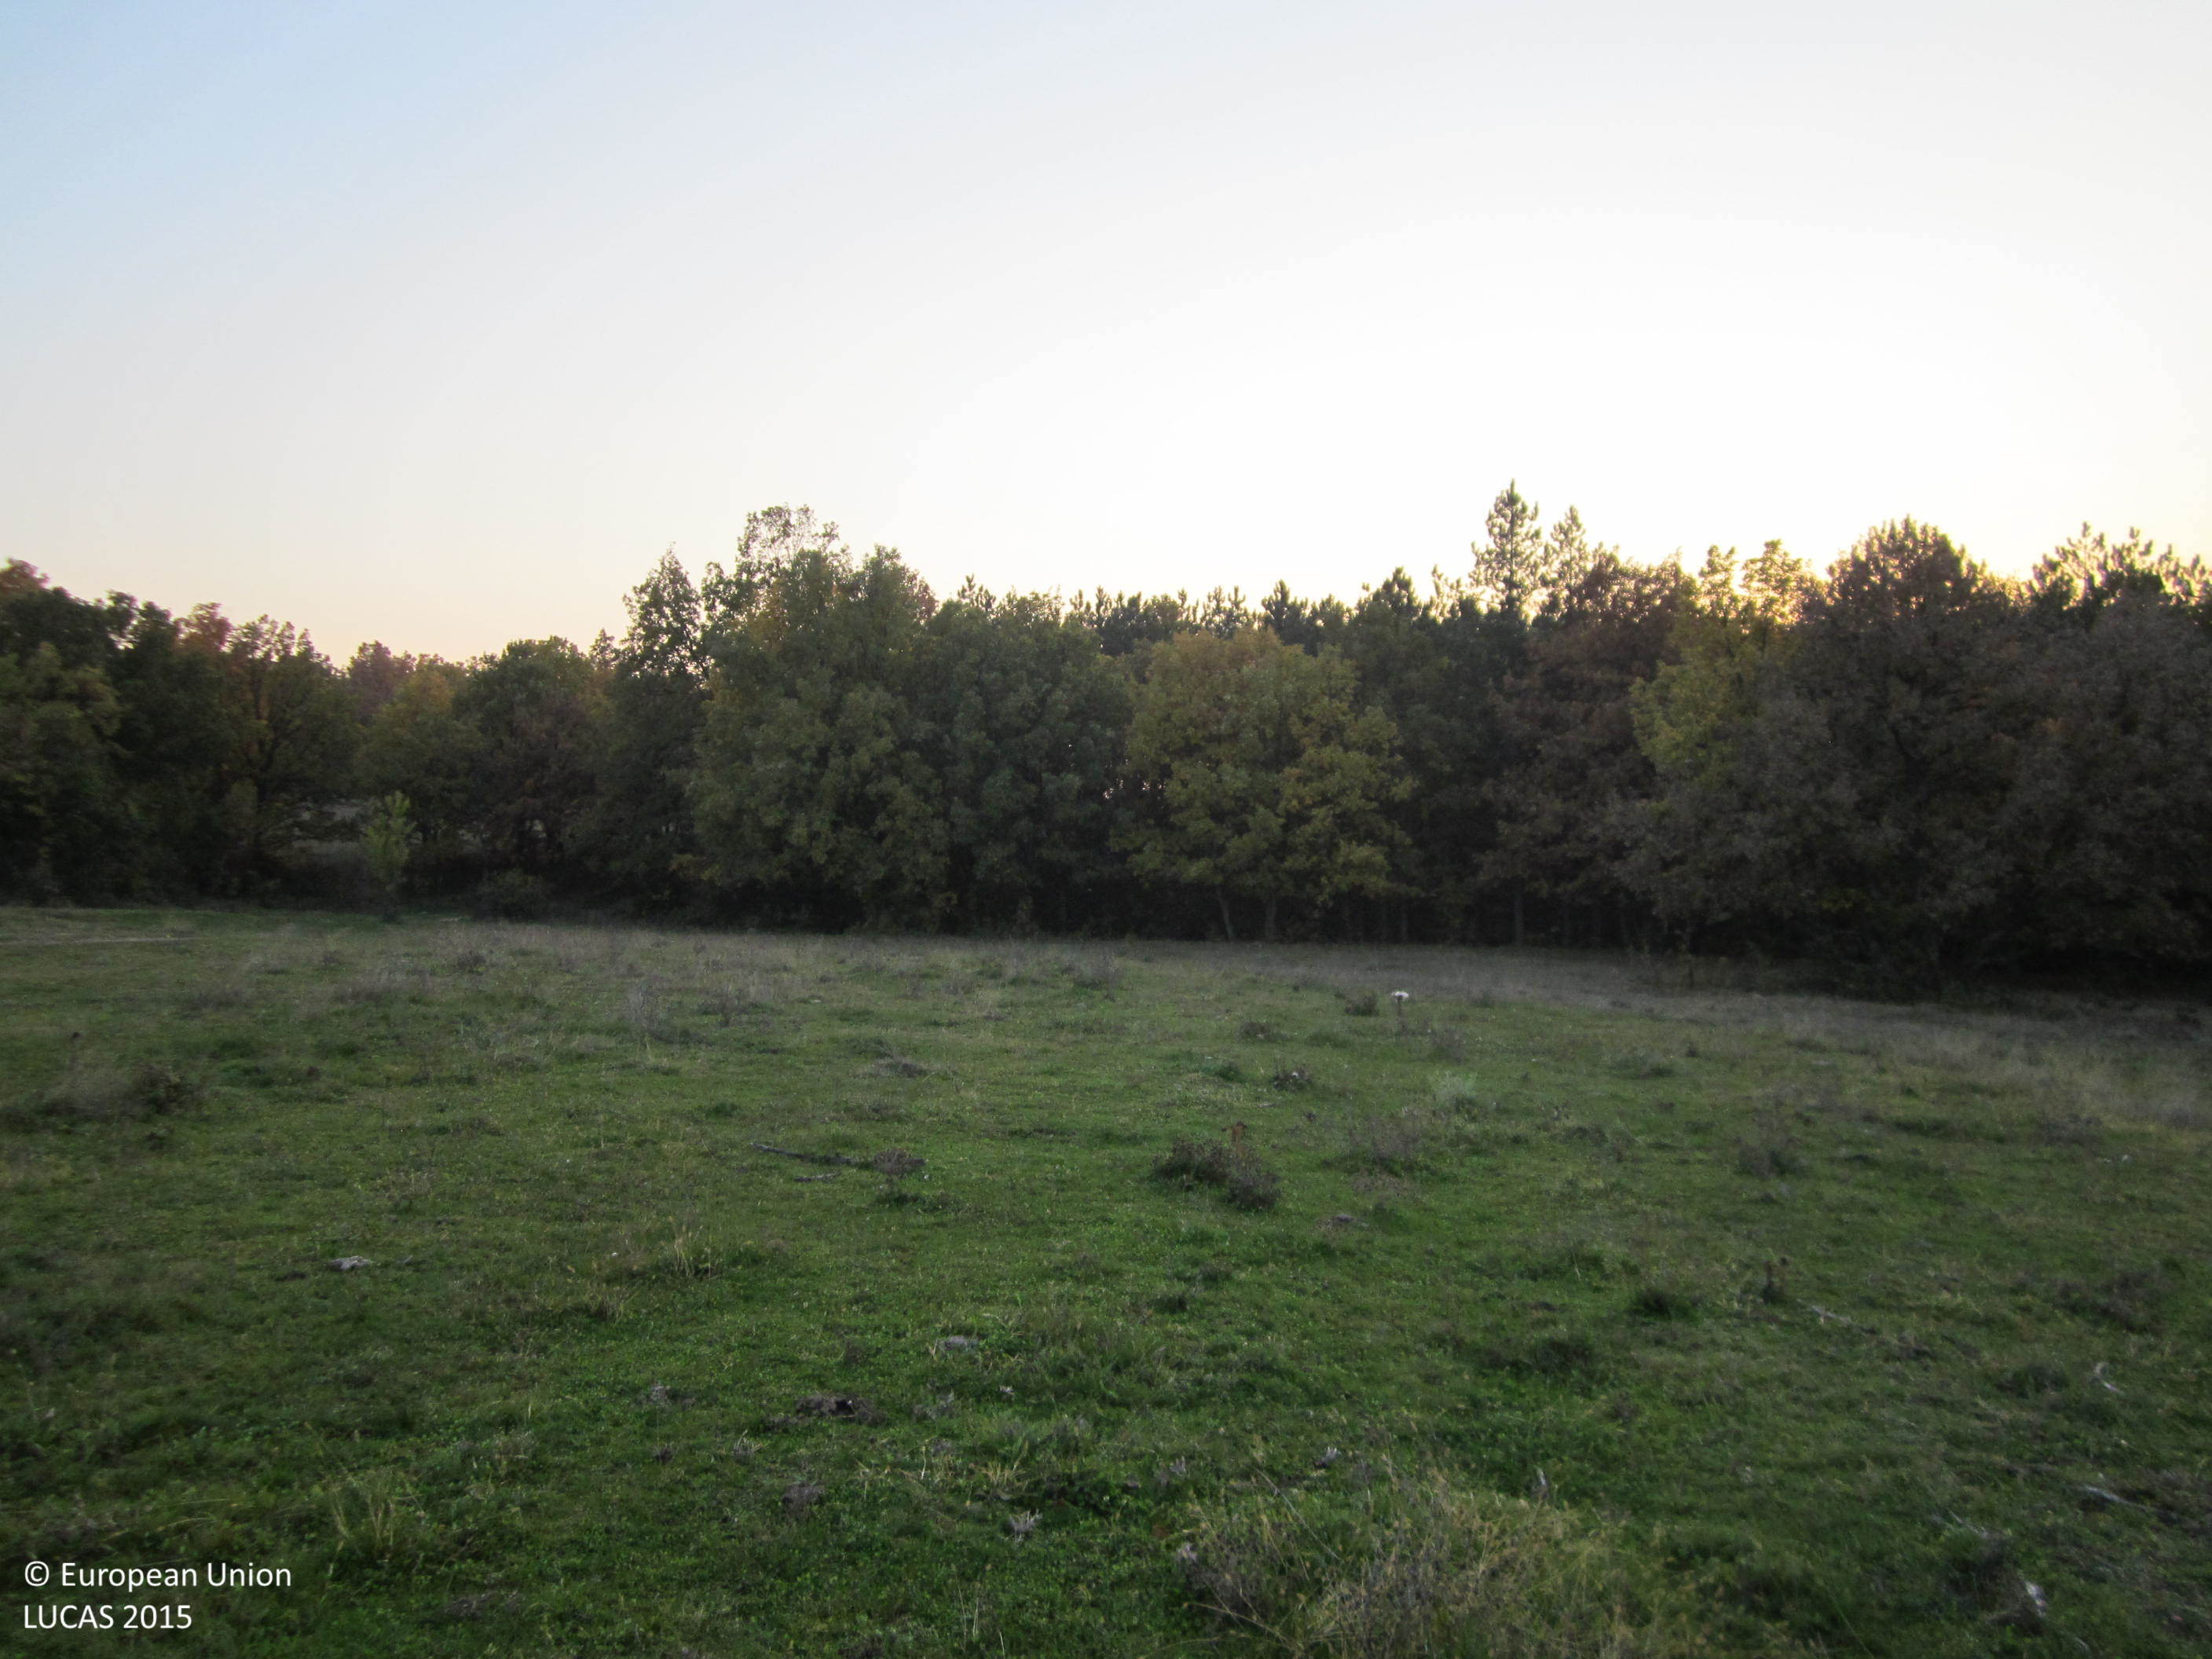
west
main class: Grassland
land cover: Grassland without tree/shrub cover
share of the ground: > 75 %
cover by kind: herbaceous plants 100 %
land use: Agriculture (excluding fallow land and kitchen gardens)
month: November
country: BG
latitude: 42.4993
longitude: 24.6435
